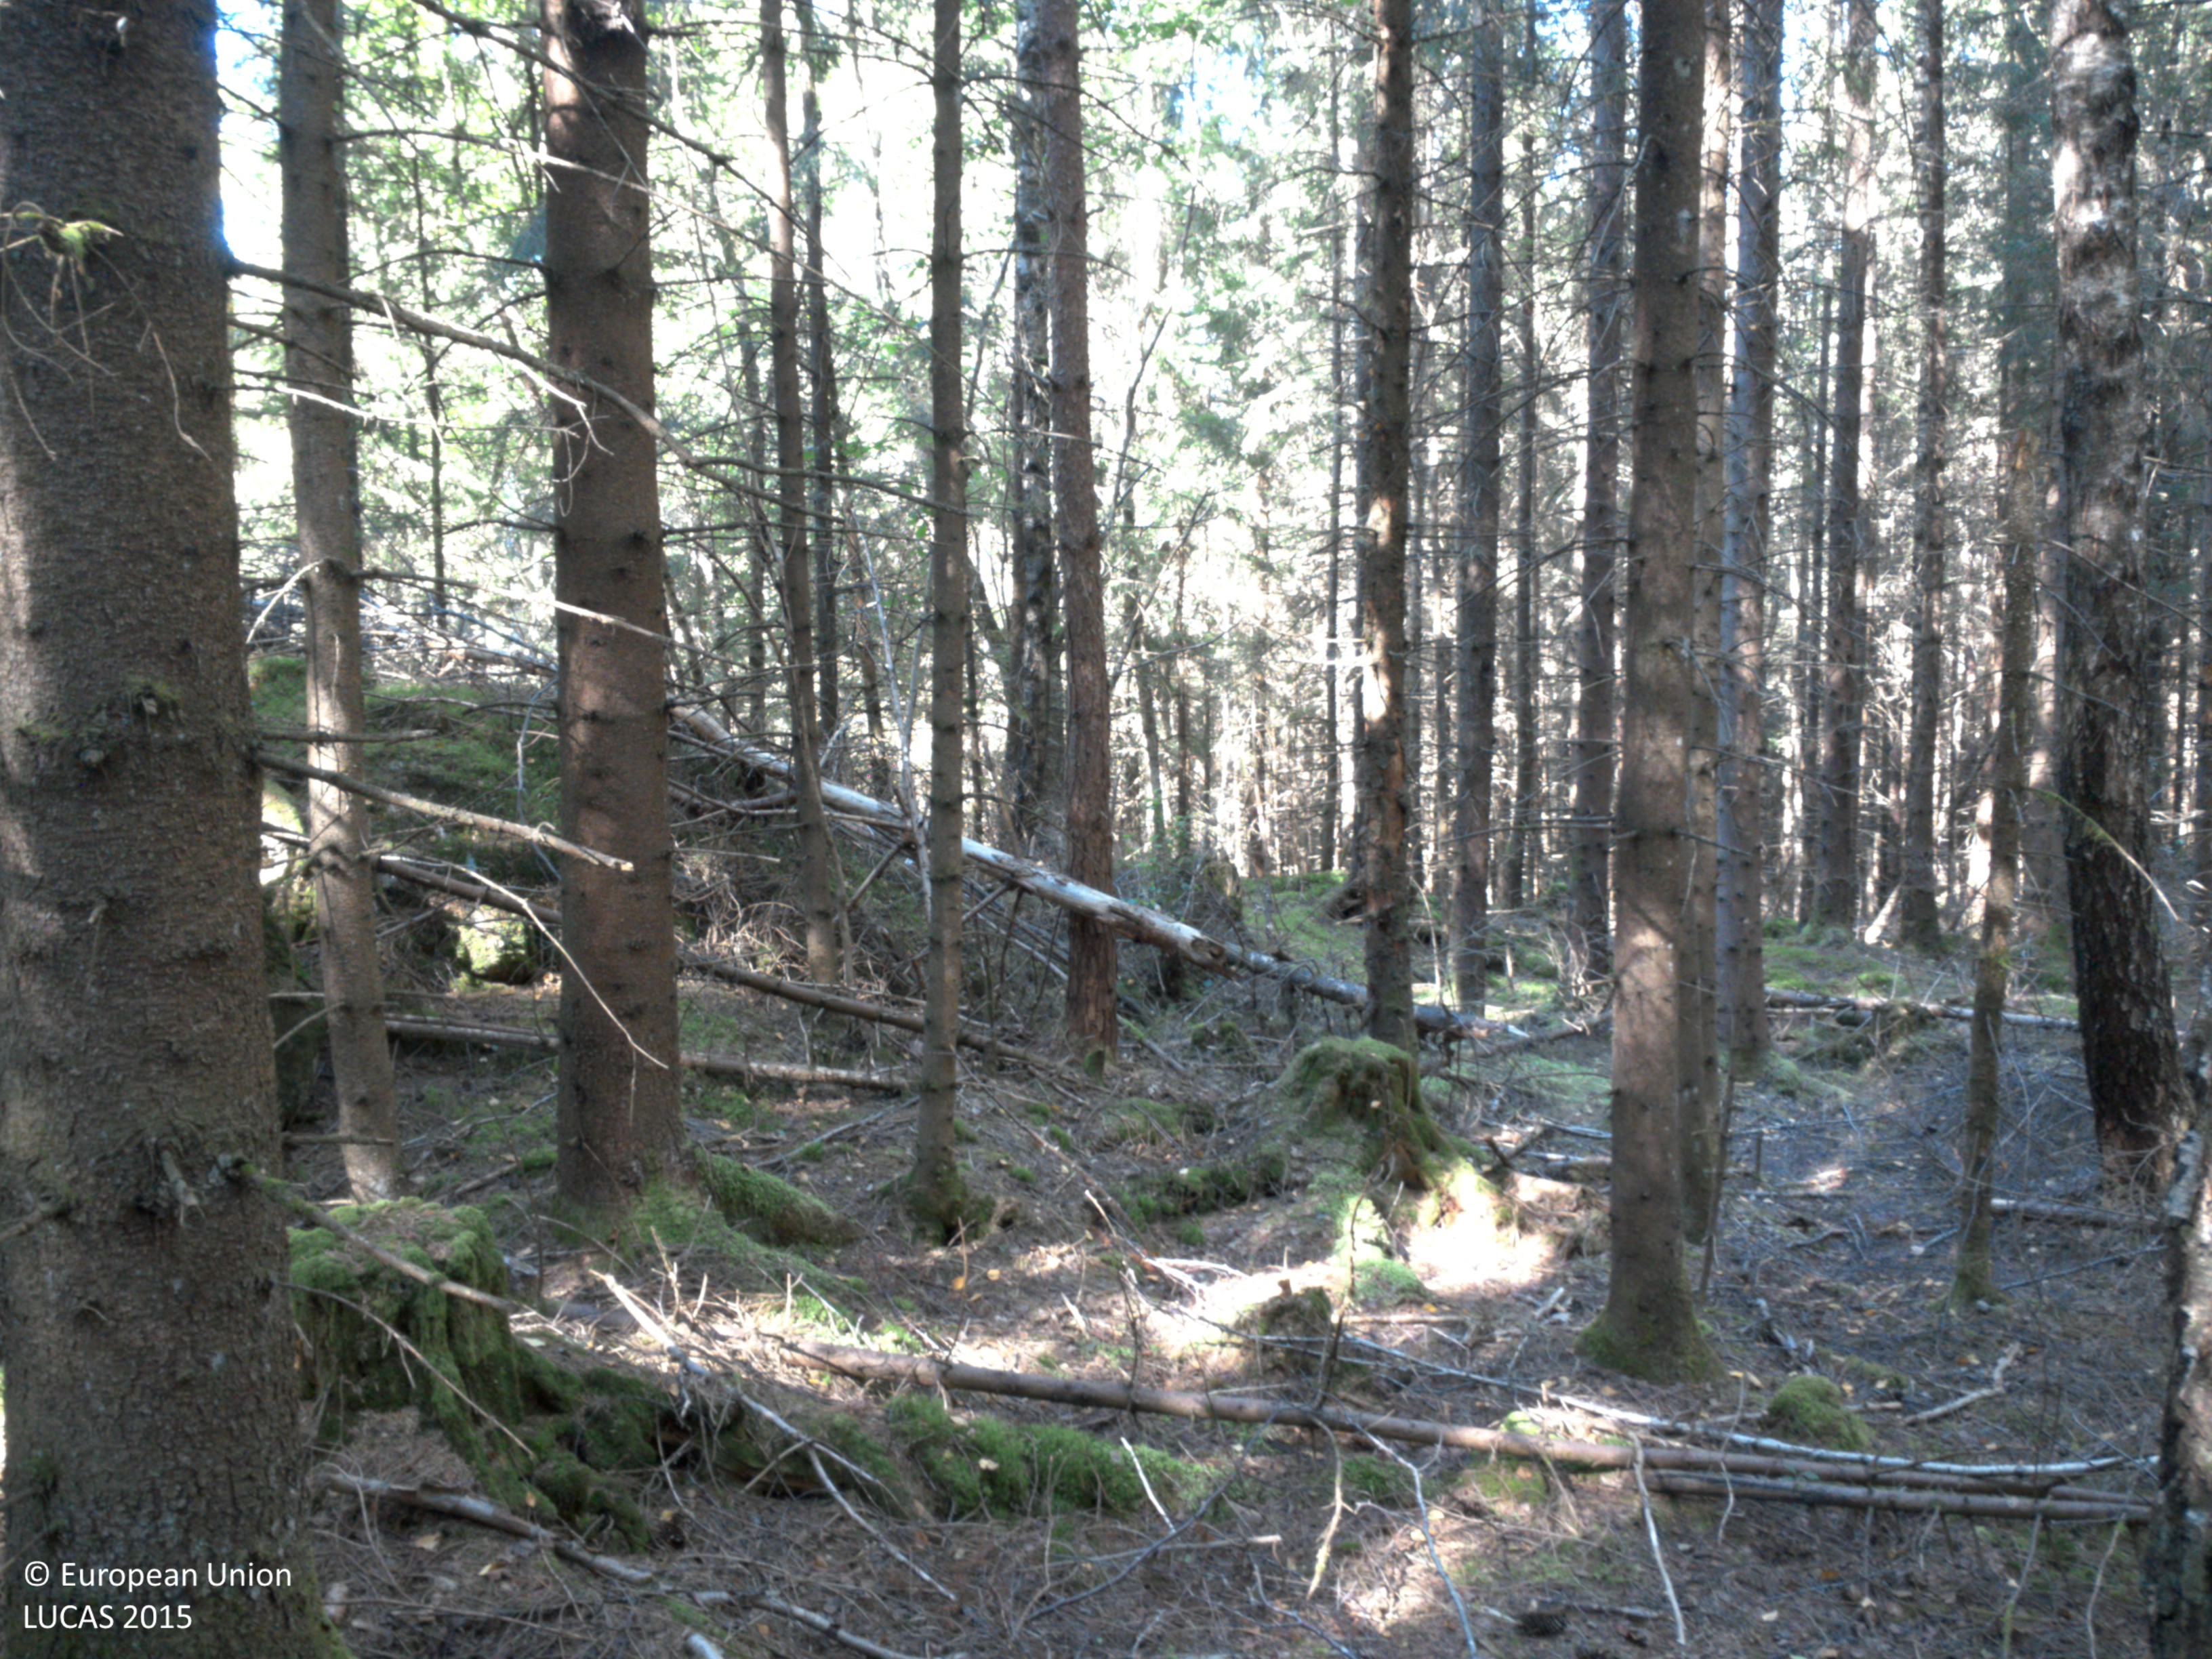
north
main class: Woodland
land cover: Spruce dominated mixed woodland
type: boreal forest
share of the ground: > 75 %
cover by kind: coniferous forest trees 60 %, broadleaved forest trees 20 %, lichens and mosses 20 %
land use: Forestry
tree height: > 5 m
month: August
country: SE
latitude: 58.2191
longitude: 12.2259
